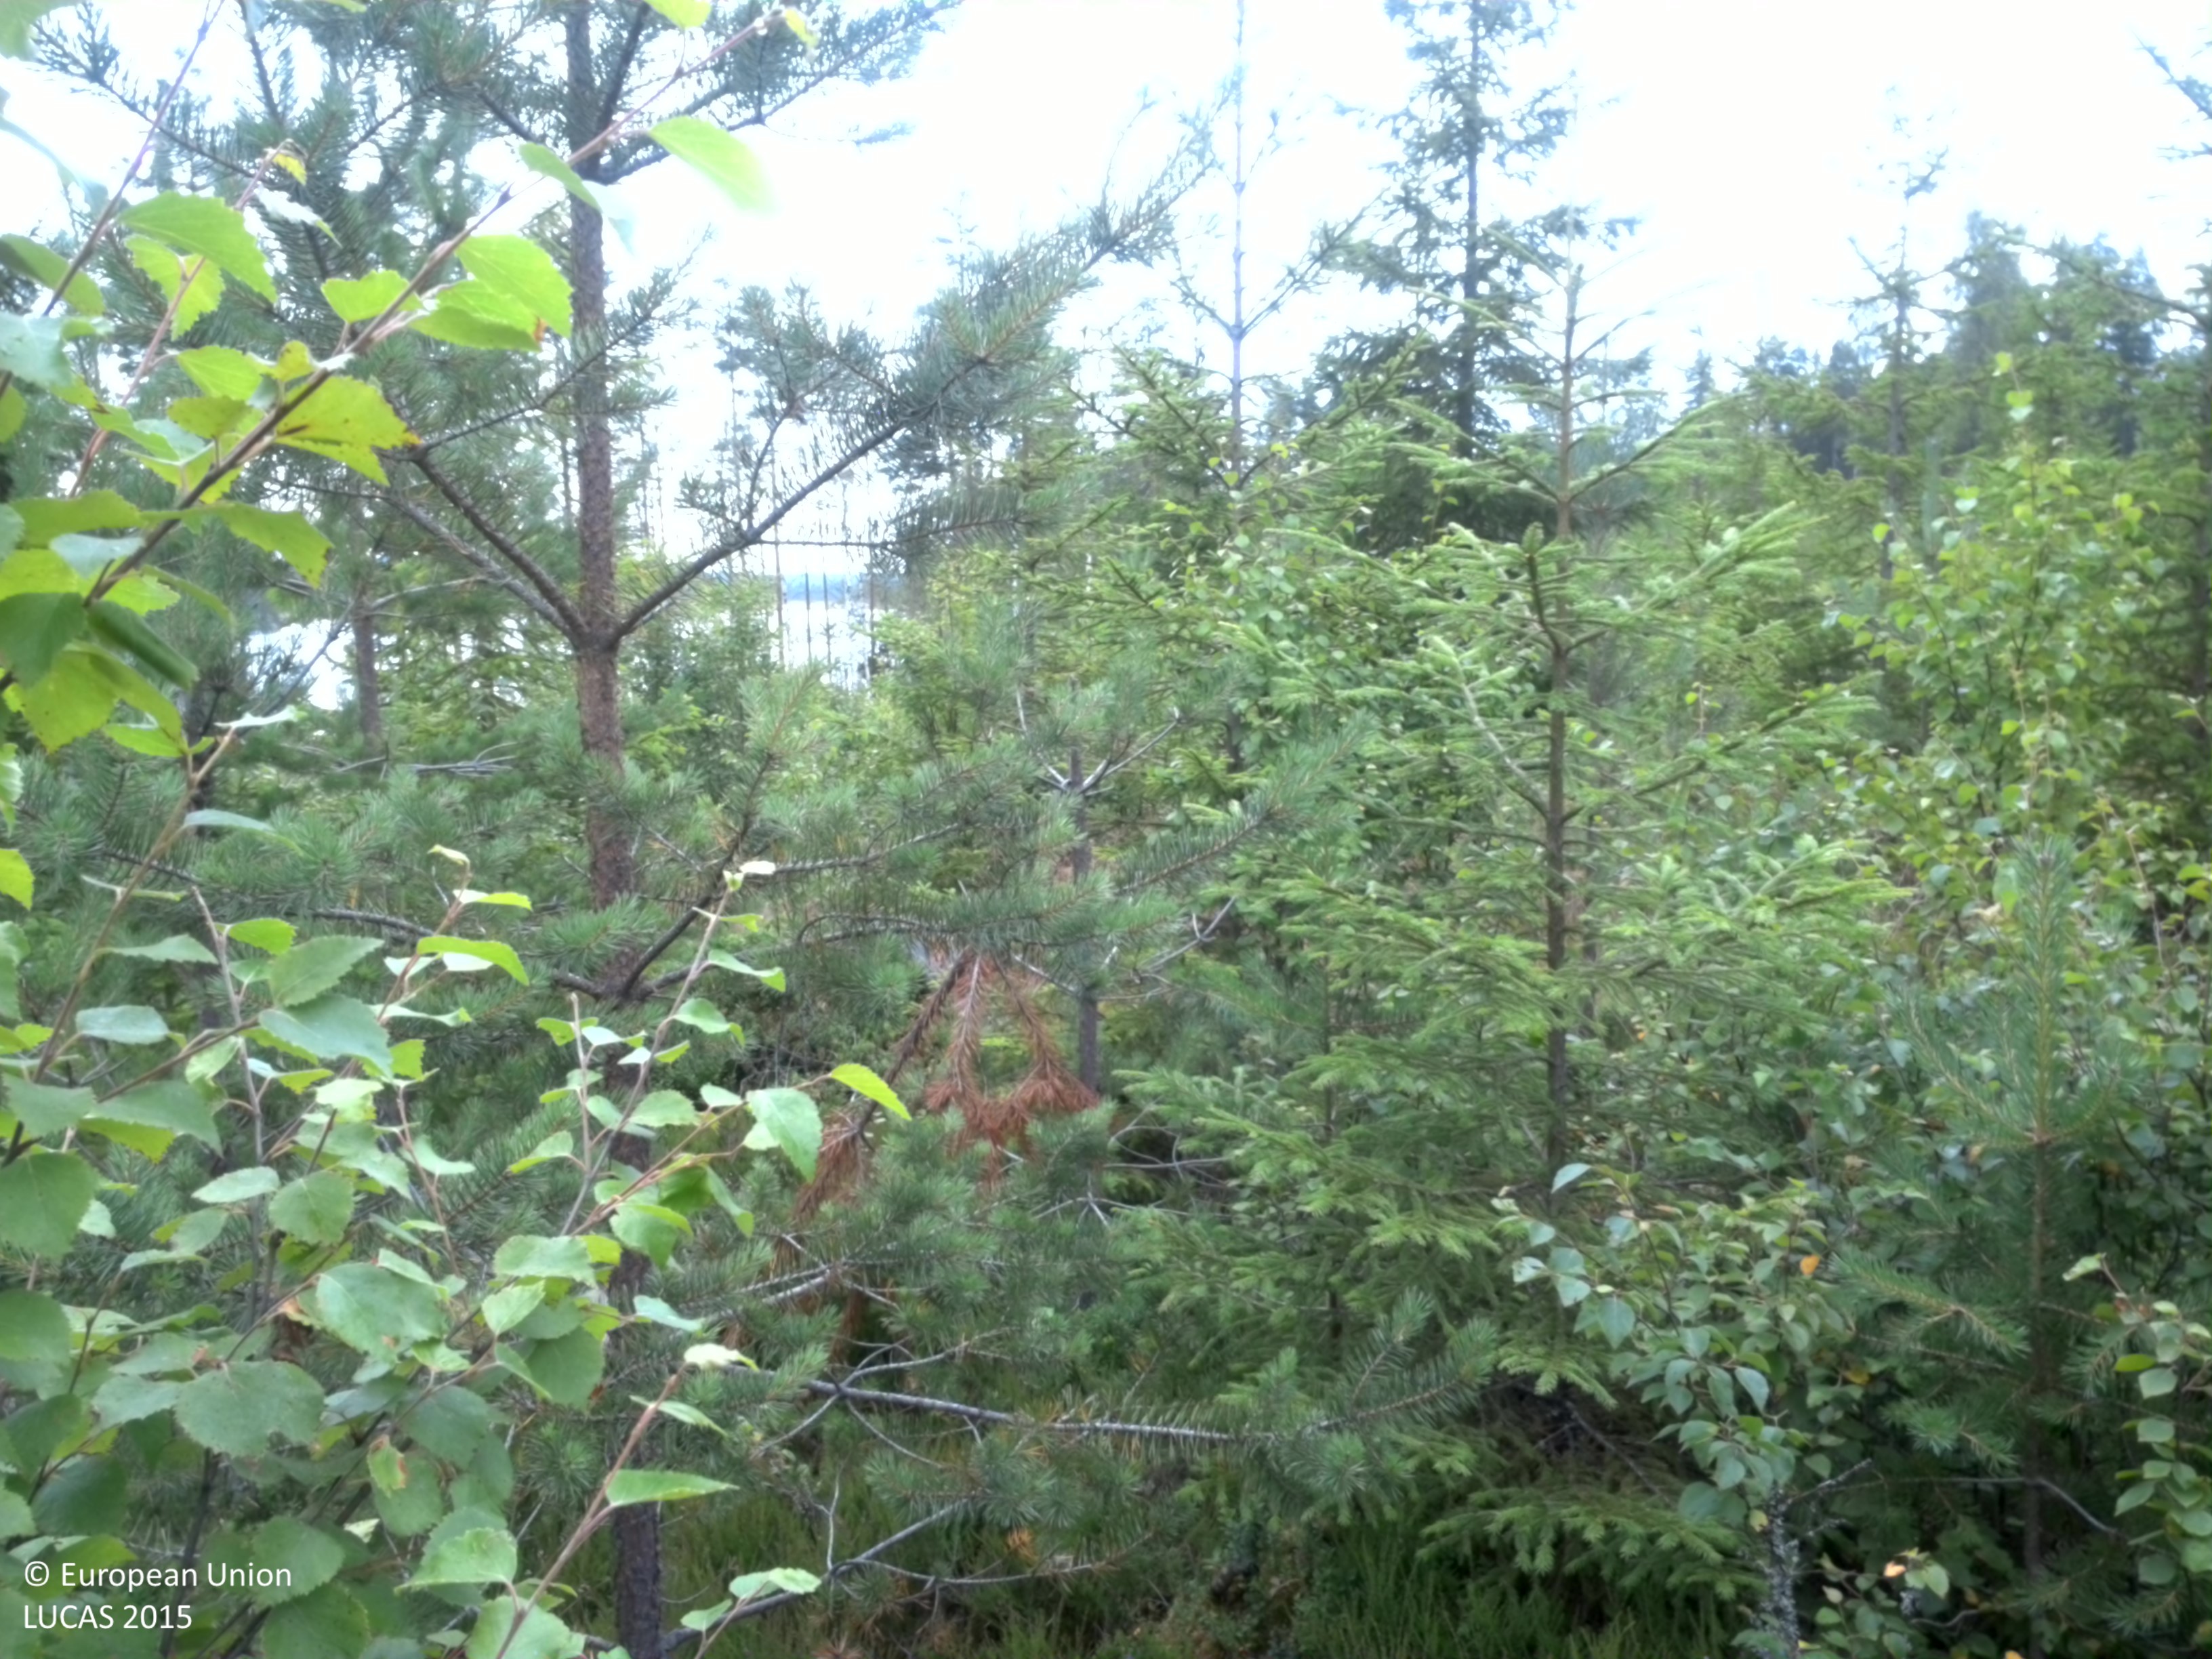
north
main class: Woodland
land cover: Spruce dominated mixed woodland
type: boreal forest
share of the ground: > 75 %
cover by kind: broadleaved forest trees 45 %, coniferous forest trees 35 %, shrubs 10 %, herbaceous plants 10 %
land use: Forestry
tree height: < 5 m
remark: Clear cut
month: August
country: SE
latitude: 60.1567
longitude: 14.1151
